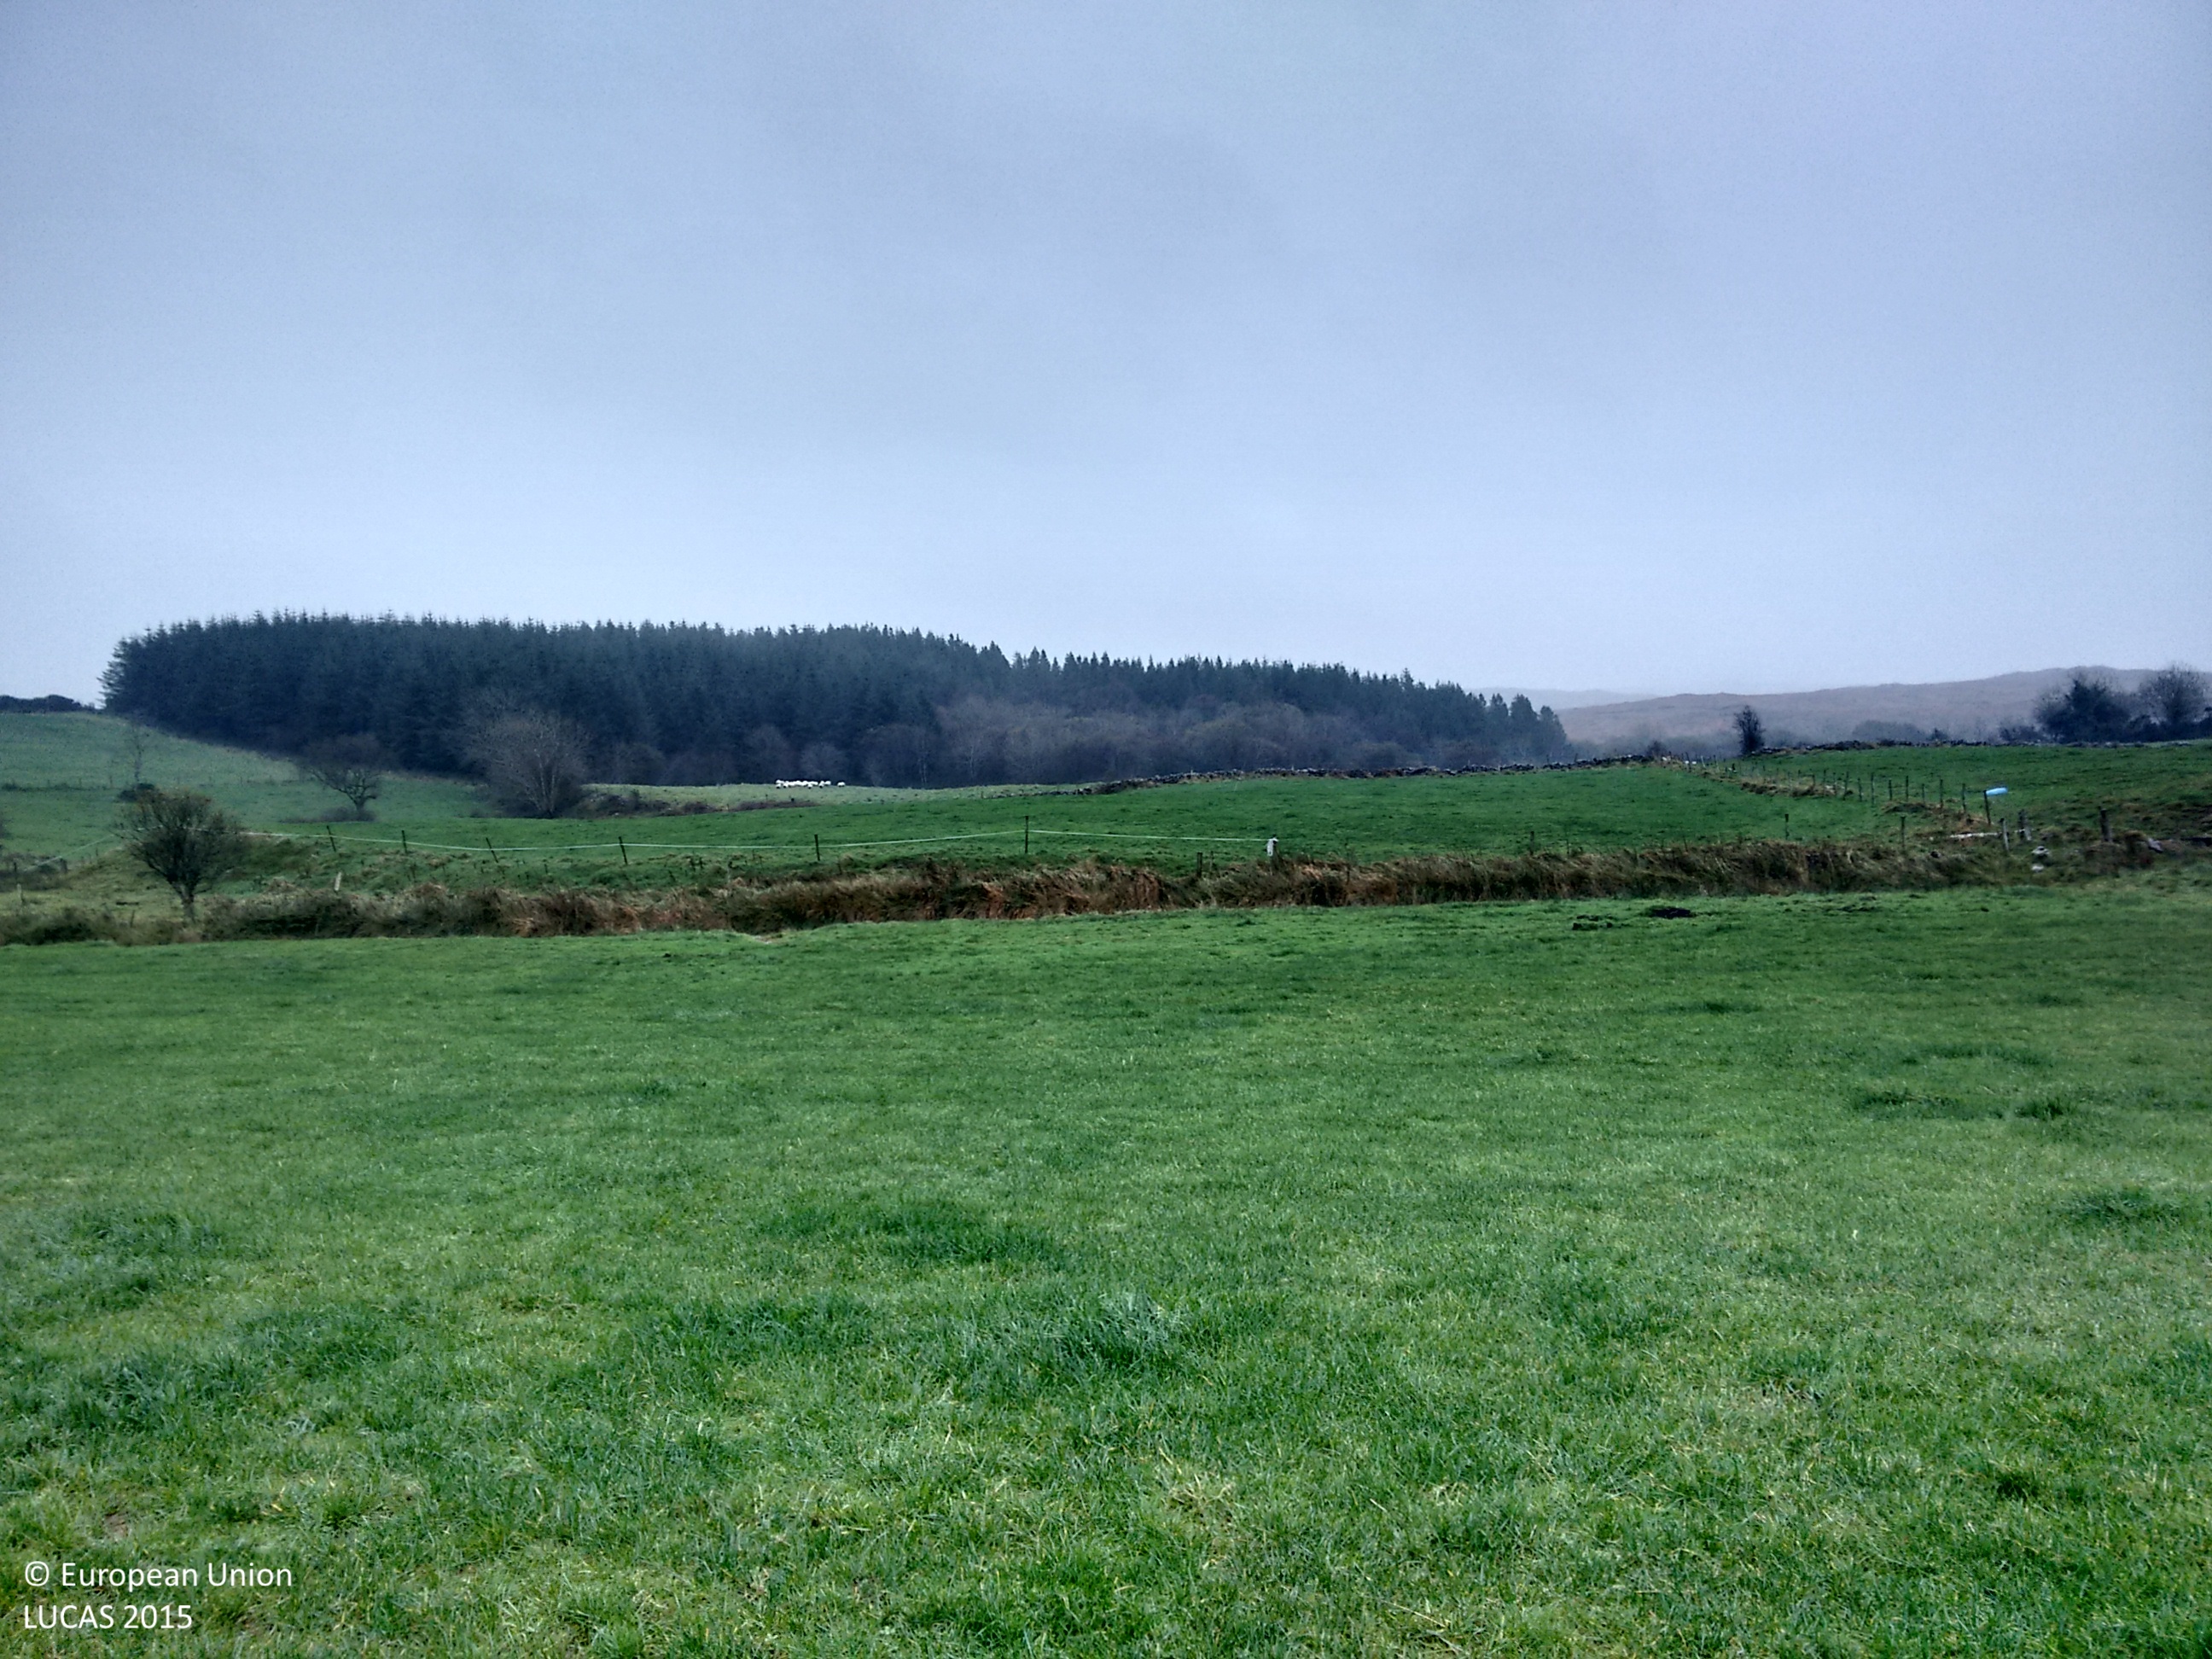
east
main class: Grassland
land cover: Grassland without tree/shrub cover
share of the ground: > 75 %
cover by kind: herbaceous plants 100 %
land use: Agriculture (excluding fallow land and kitchen gardens)
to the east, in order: Grassland without tree/shrub cover; Ditches and canals; Fences; Tracks; Fences; Grassland without tree/shrub cover; Dry stone walls; Fences; Grassland without tree/shrub cover; Fences; Electric lines; Pine dominated coniferous woodland
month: November
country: IE
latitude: 54.5341
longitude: -8.0875
